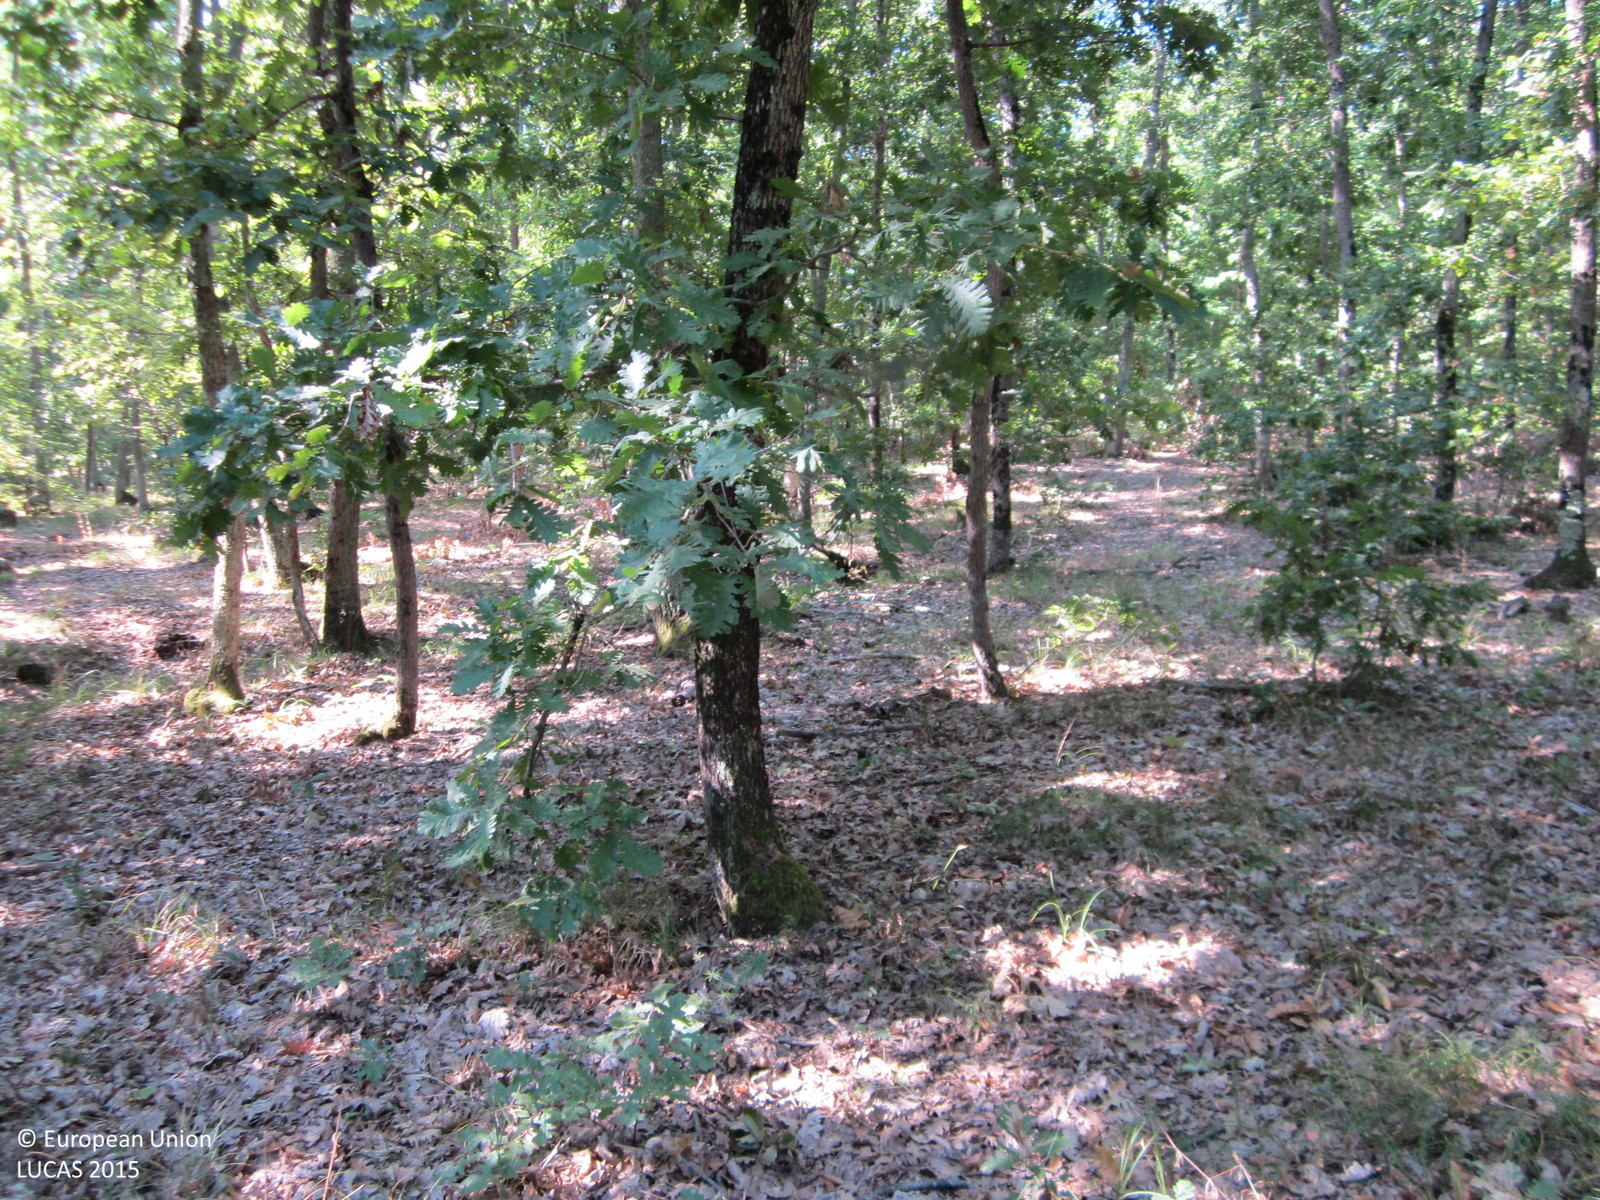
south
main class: Woodland
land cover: Broadleaved woodland
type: thermophilous deciduous forest
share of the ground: > 75 %
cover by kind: broadleaved forest trees 85 %, unconsolidated bare surface 10 %, herbaceous plants 5 %
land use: Forestry
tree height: > 5 m
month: August
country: BG
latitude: 42.8841
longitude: 27.8244
